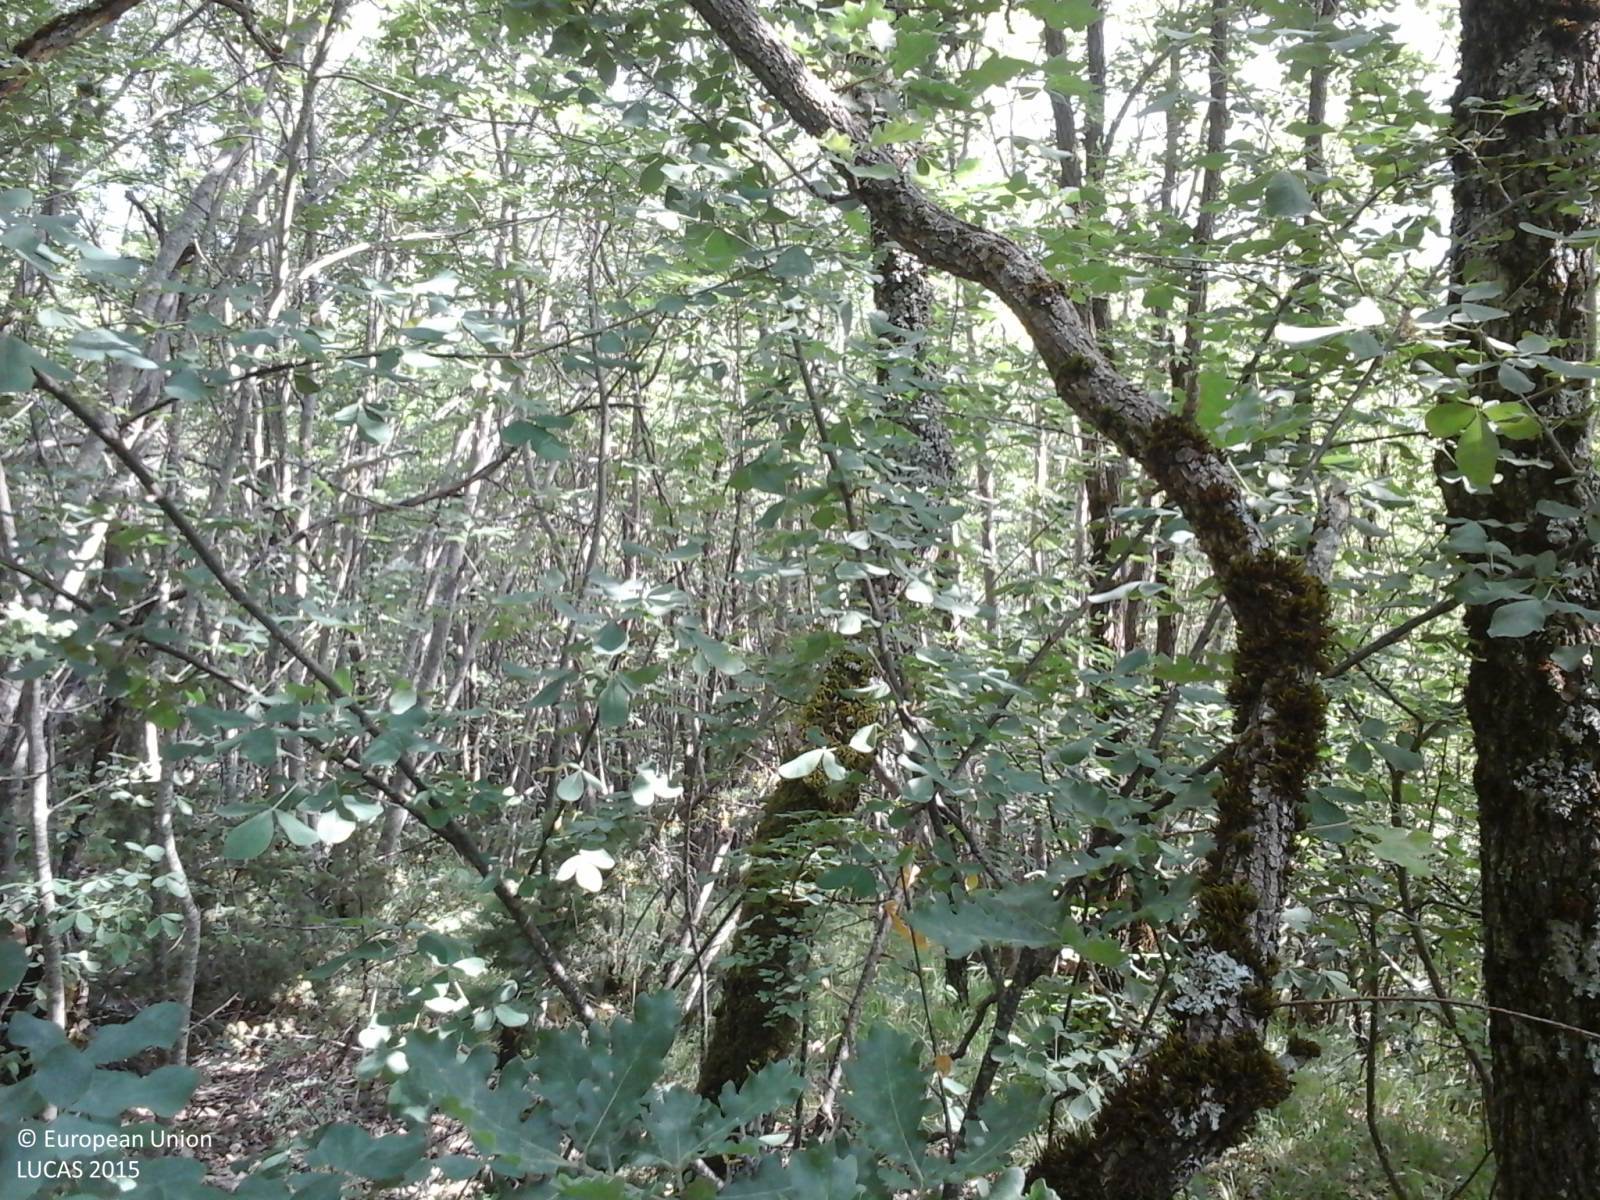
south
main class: Woodland
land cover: Broadleaved woodland
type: thermophilous deciduous forest
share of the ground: > 75 %
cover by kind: broadleaved forest trees 100 %
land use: Forestry
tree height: > 5 m
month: July
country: IT
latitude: 42.4600
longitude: 13.1638
